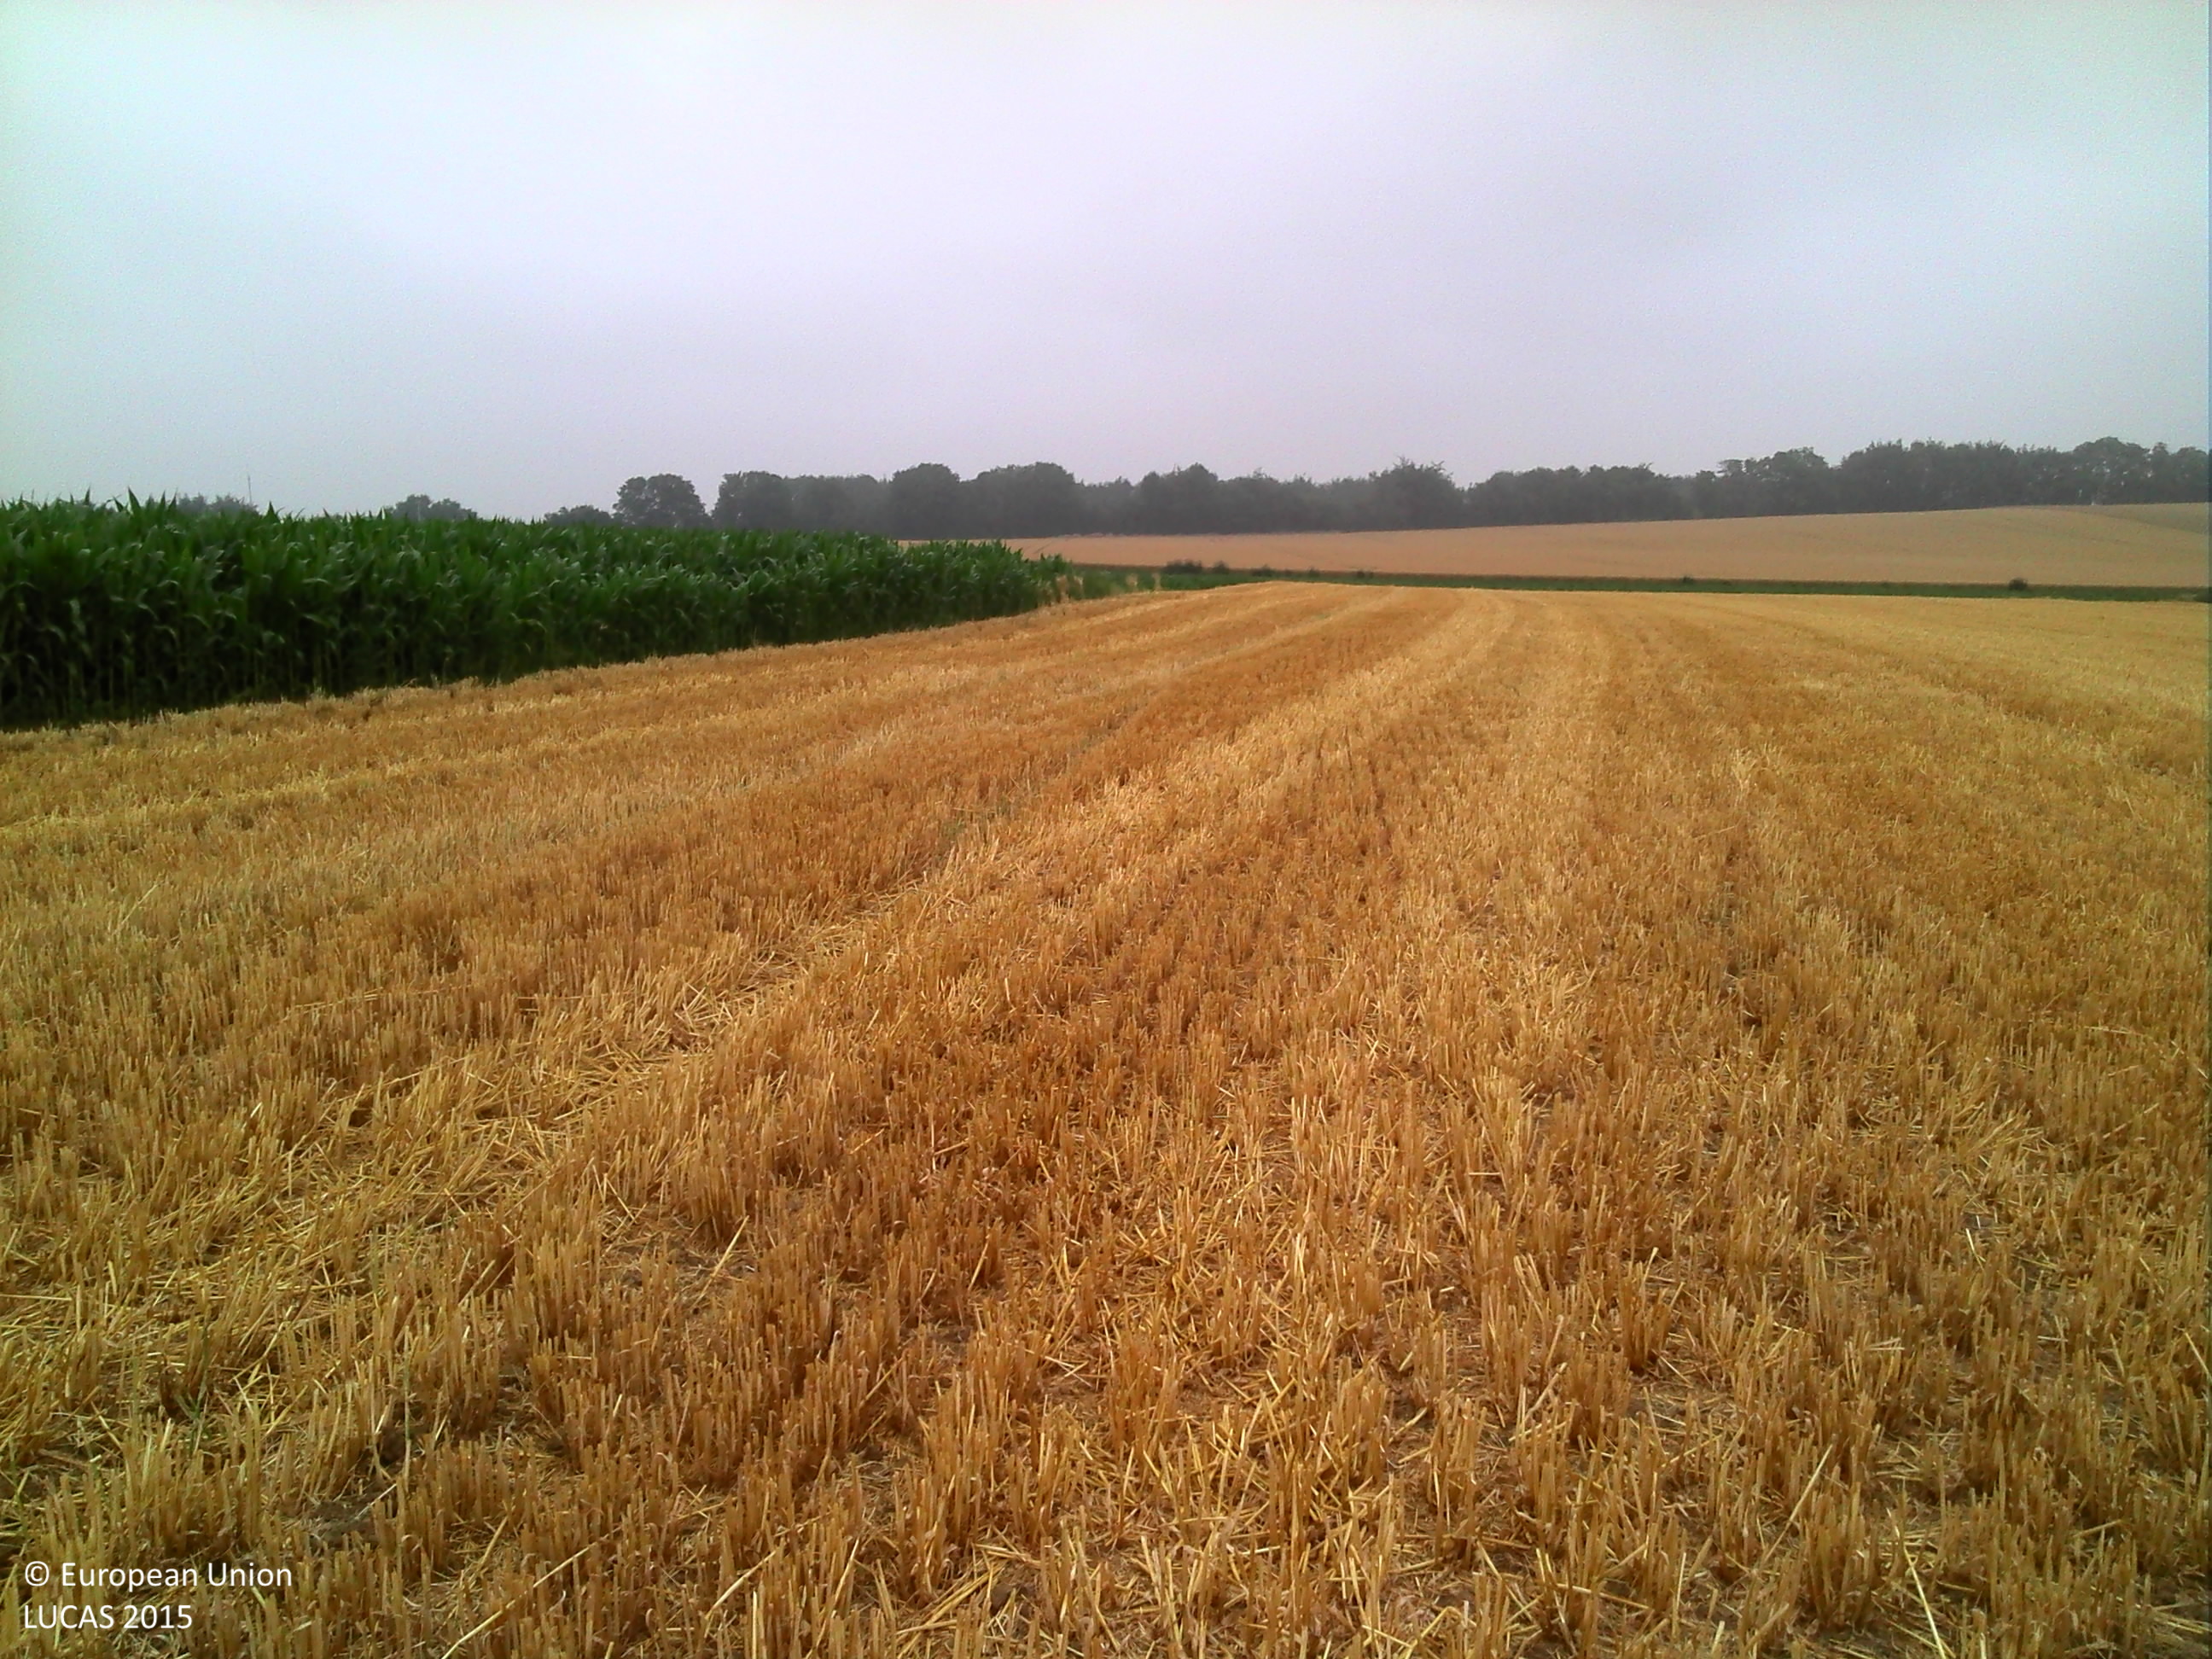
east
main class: Cropland
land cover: Barley
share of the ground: > 75 %
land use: Agriculture (excluding fallow land and kitchen gardens)
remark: Harvested field
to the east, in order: Barley; Other non-permanent industrial crops; Common wheat
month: July
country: BE
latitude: 50.7641
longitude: 5.5606
